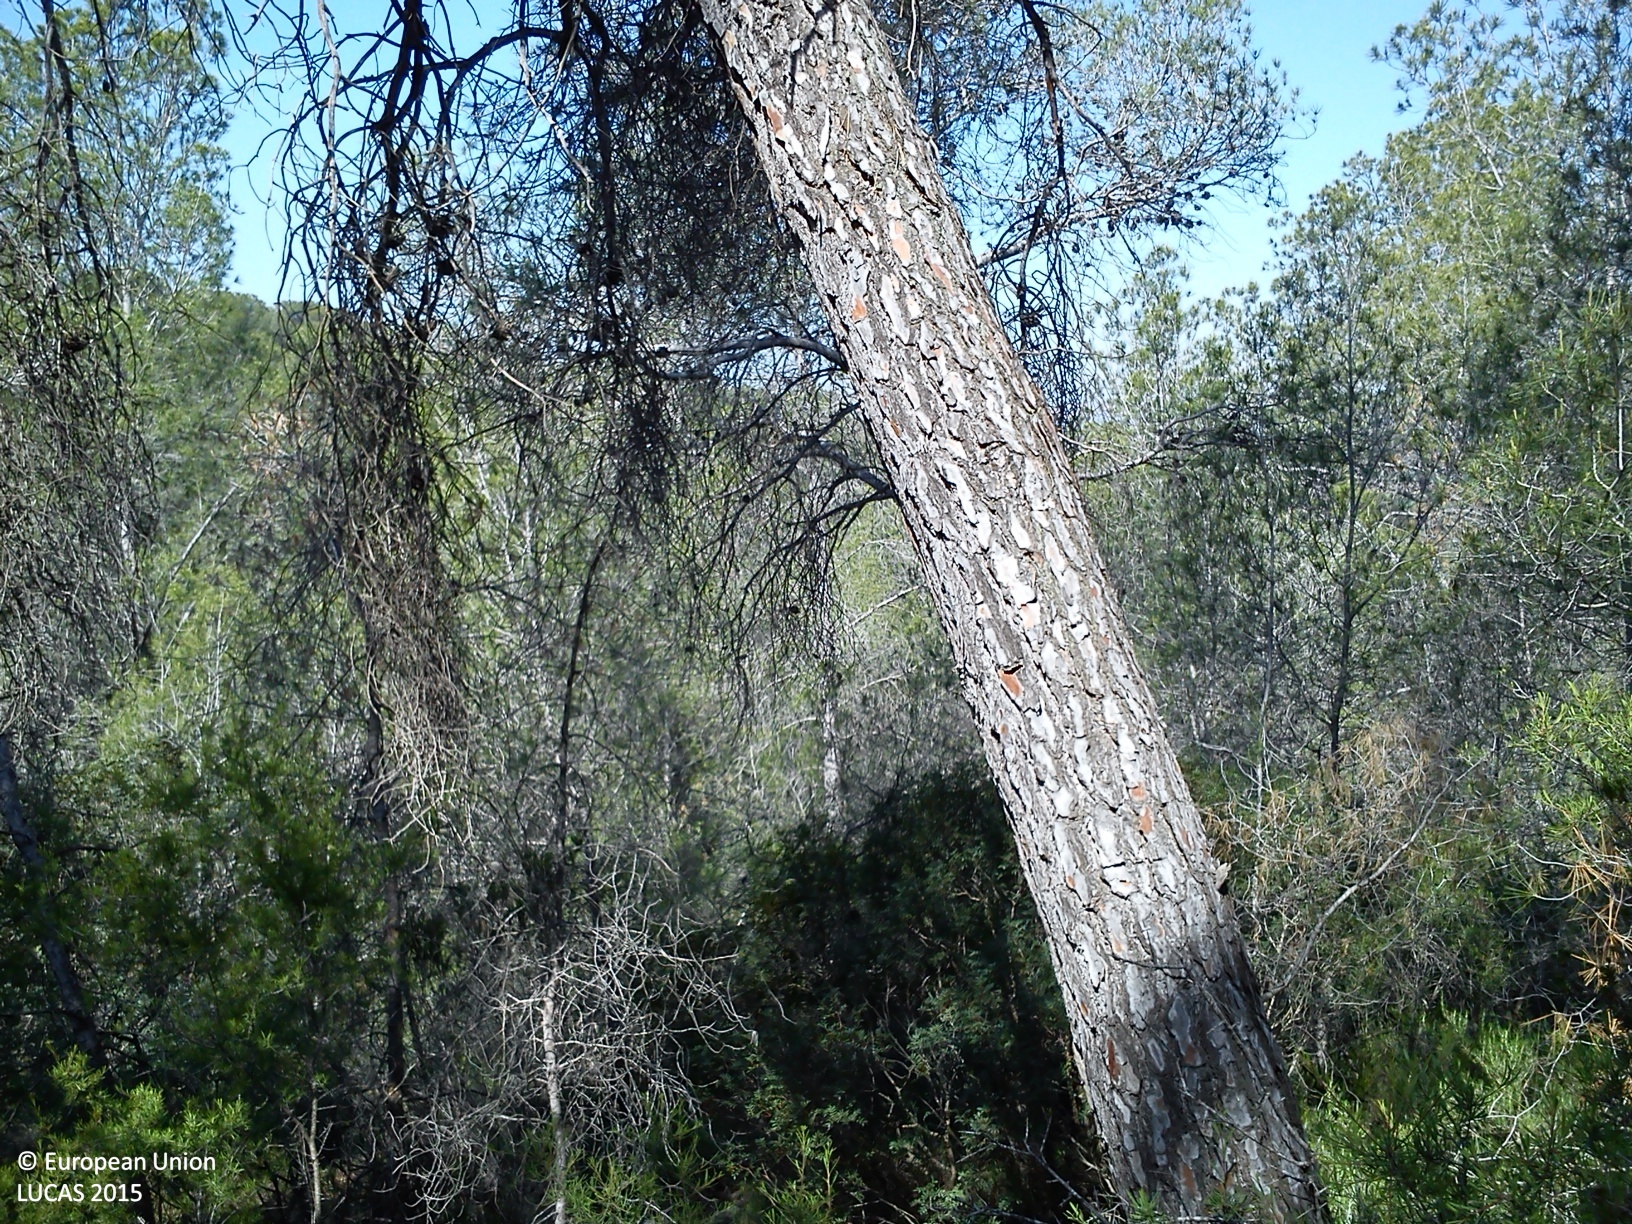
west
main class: Woodland
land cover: Pine dominated coniferous woodland
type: coniferous forest of the mediterranean region
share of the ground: > 75 %
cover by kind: coniferous forest trees 75 %, shrubs 15 %, herbaceous plants 5 %, consolidated bare surface 5 %
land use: Forestry
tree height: > 5 m
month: April
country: ES
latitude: 39.6147
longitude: -0.6348
